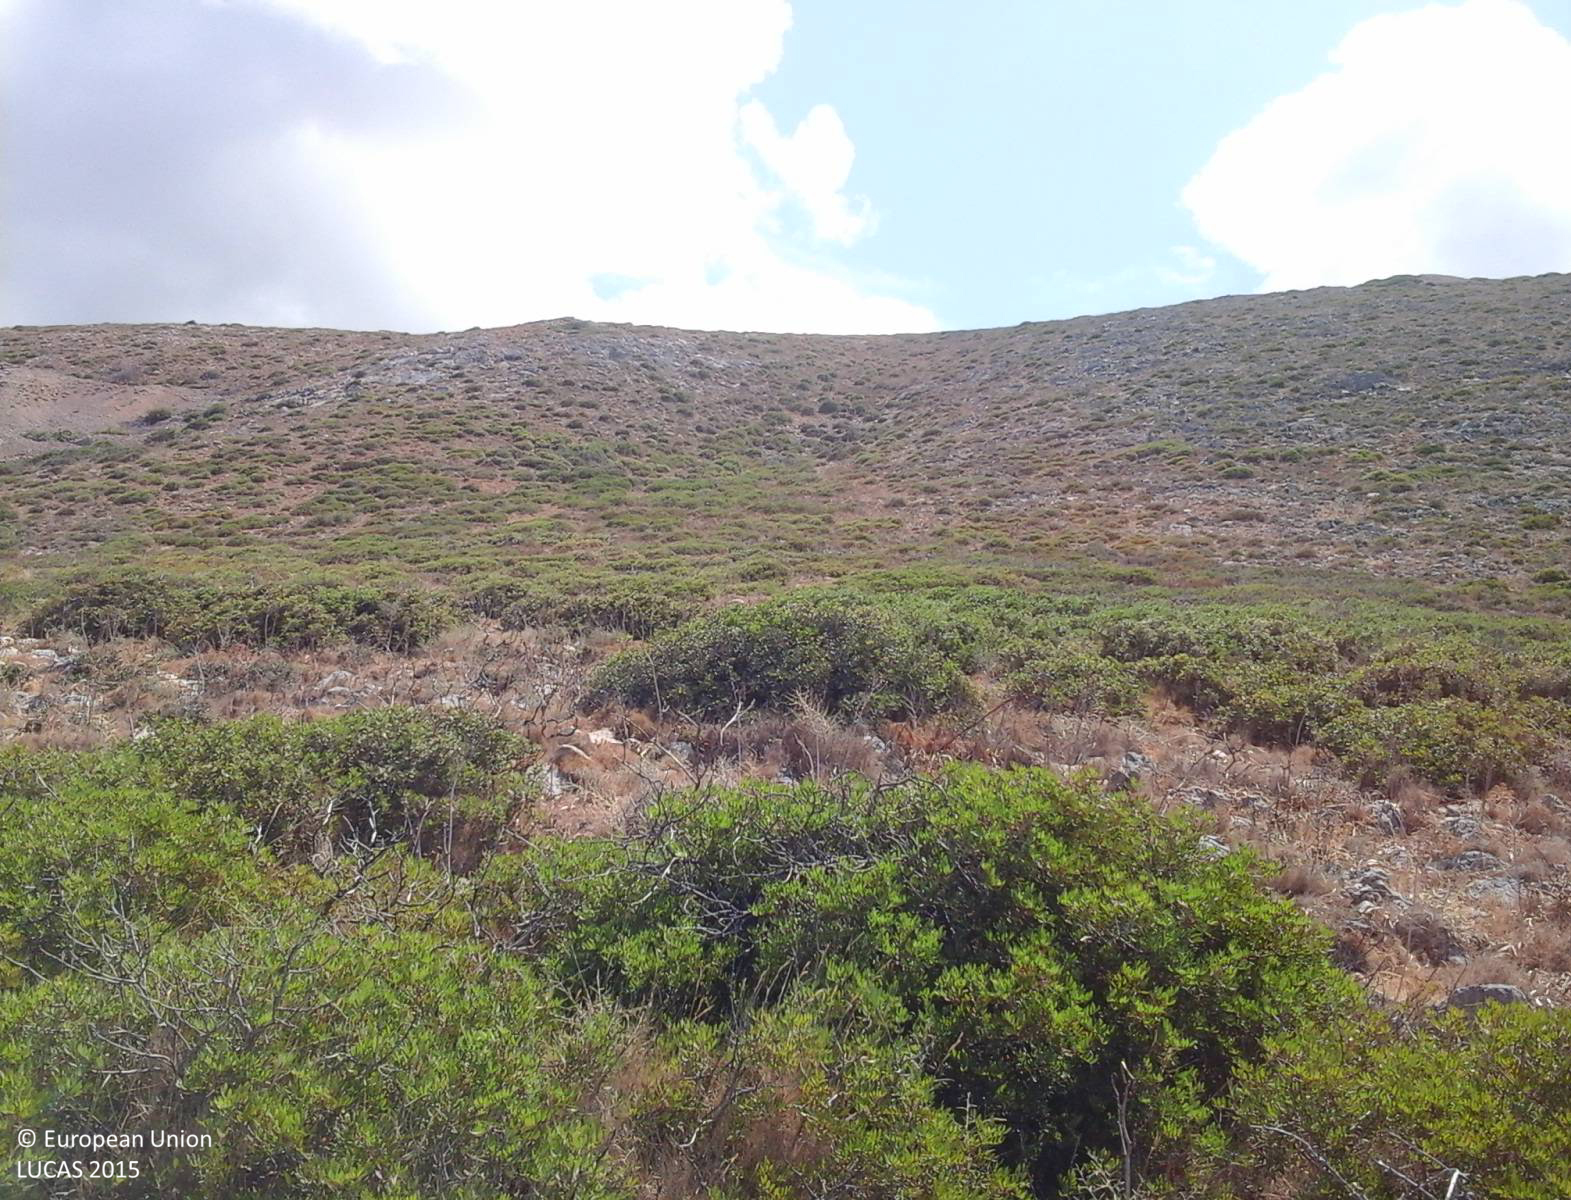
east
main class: Shrubland
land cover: Shrubland without tree cover
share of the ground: > 75 %
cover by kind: shrubs 100 %
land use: Forestry
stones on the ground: > 50 %
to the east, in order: Shrubland without tree cover
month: August
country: IT
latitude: 39.3848
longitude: 8.3959
